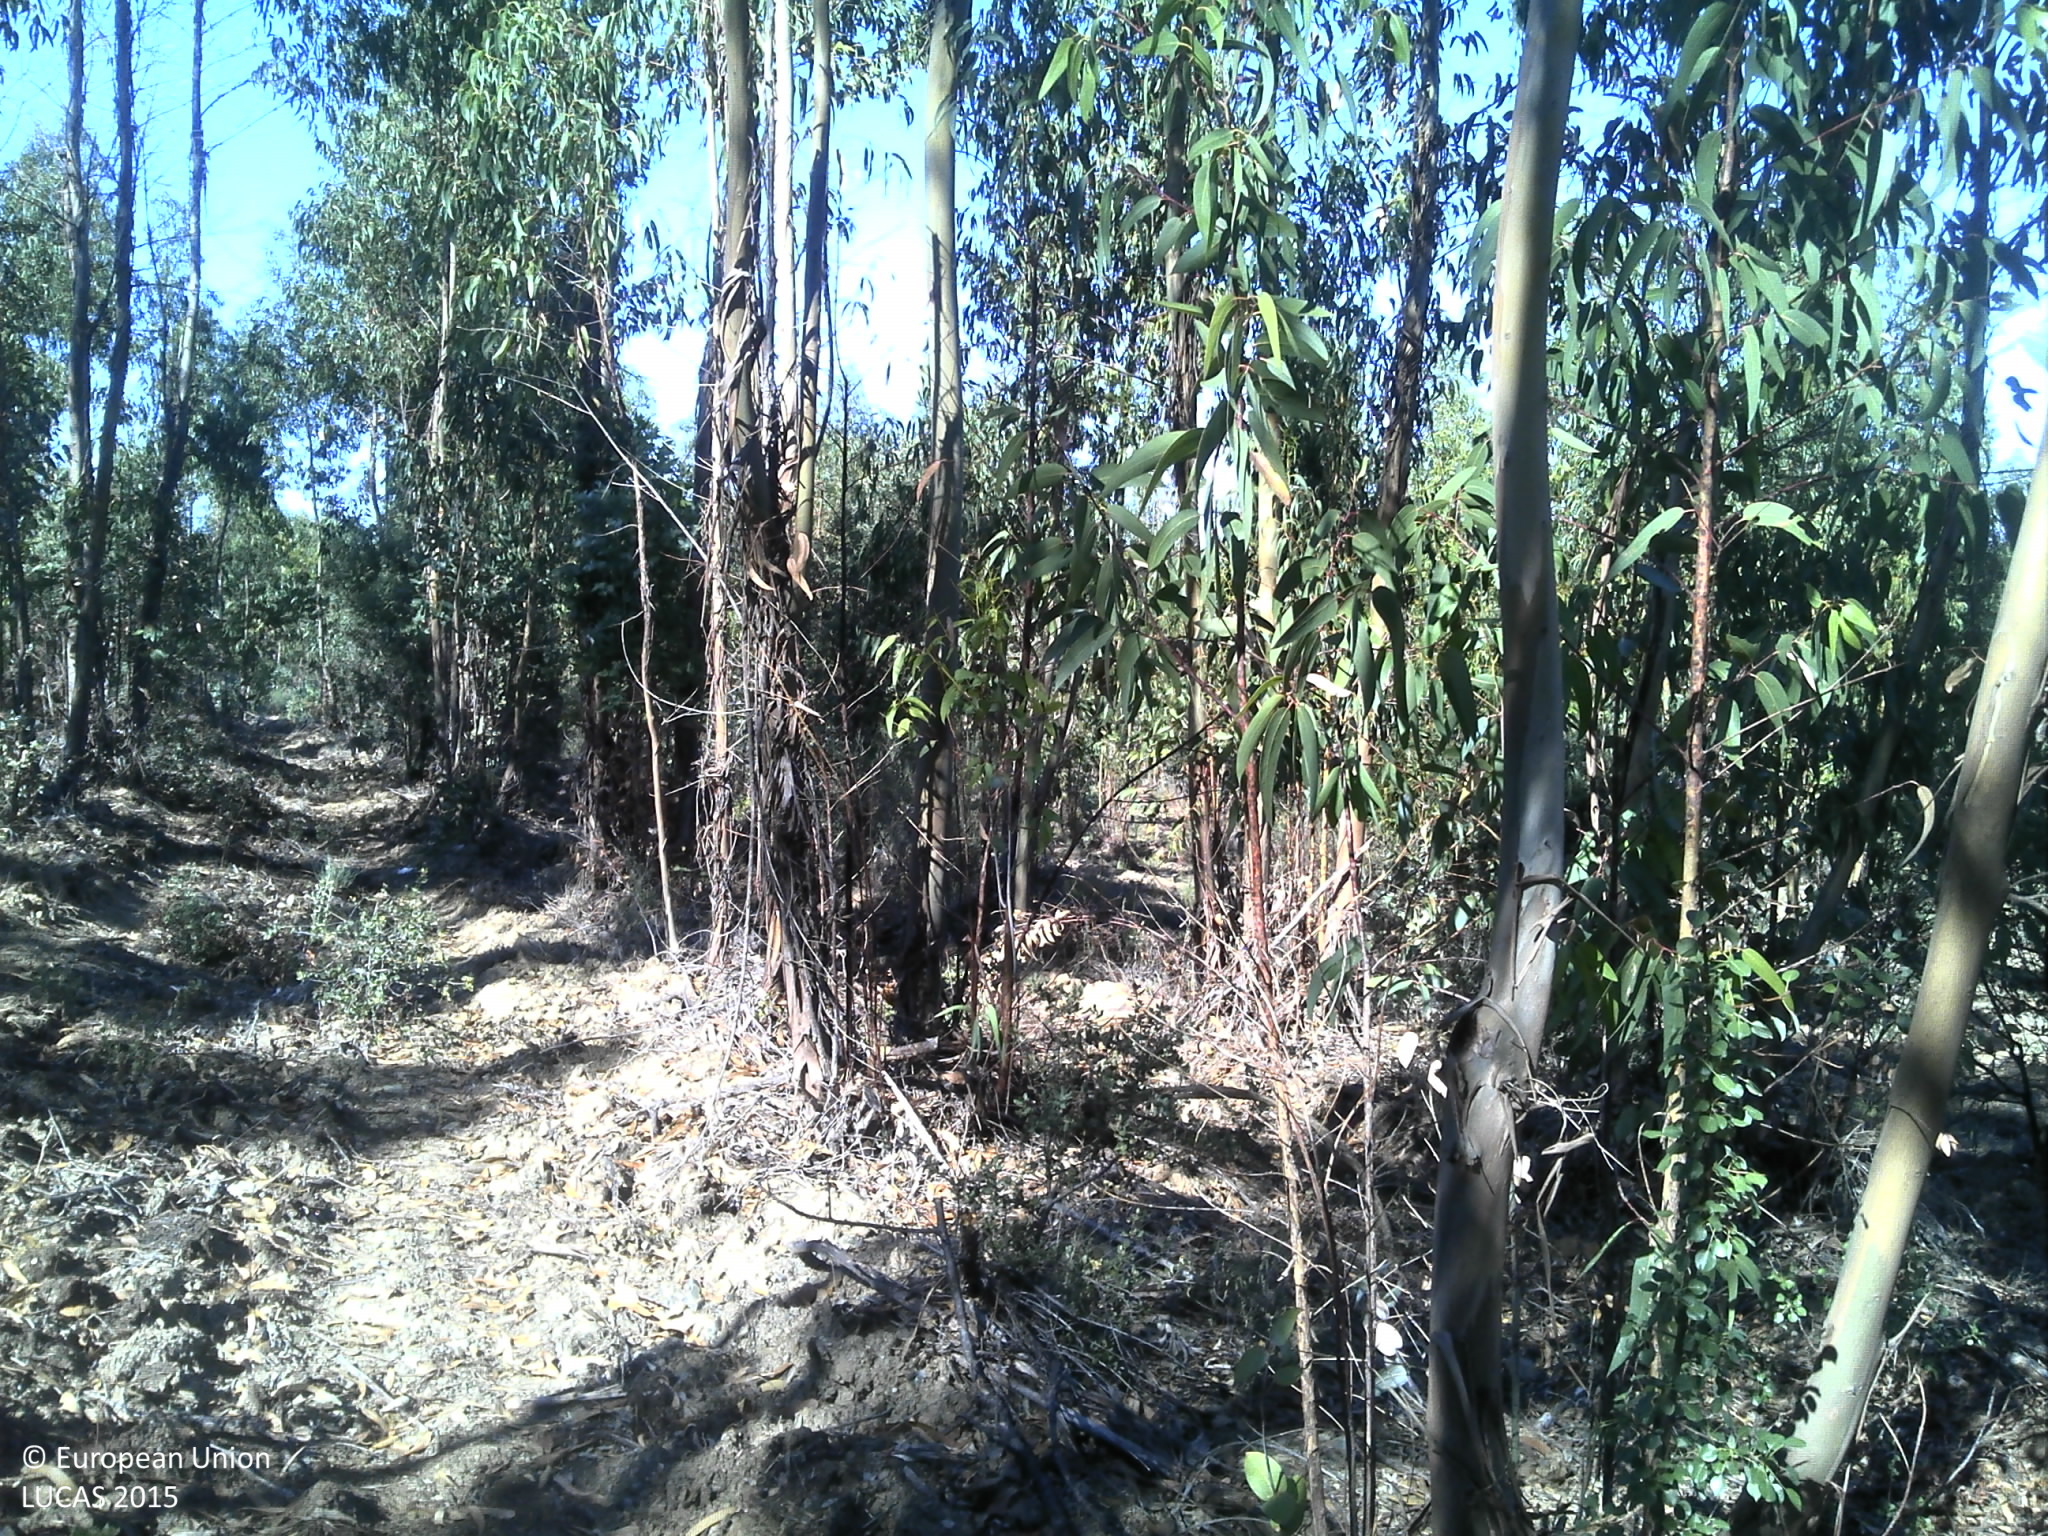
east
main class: Woodland
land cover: Broadleaved woodland
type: exotic forest
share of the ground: 50 - 75 %
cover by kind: broadleaved forest trees 75 %, unconsolidated bare surface 15 %, shrubs 5 %
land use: Forestry
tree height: > 5 m
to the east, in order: Broadleaved woodland
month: June
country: PT
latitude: 40.0416
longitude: -7.2198
